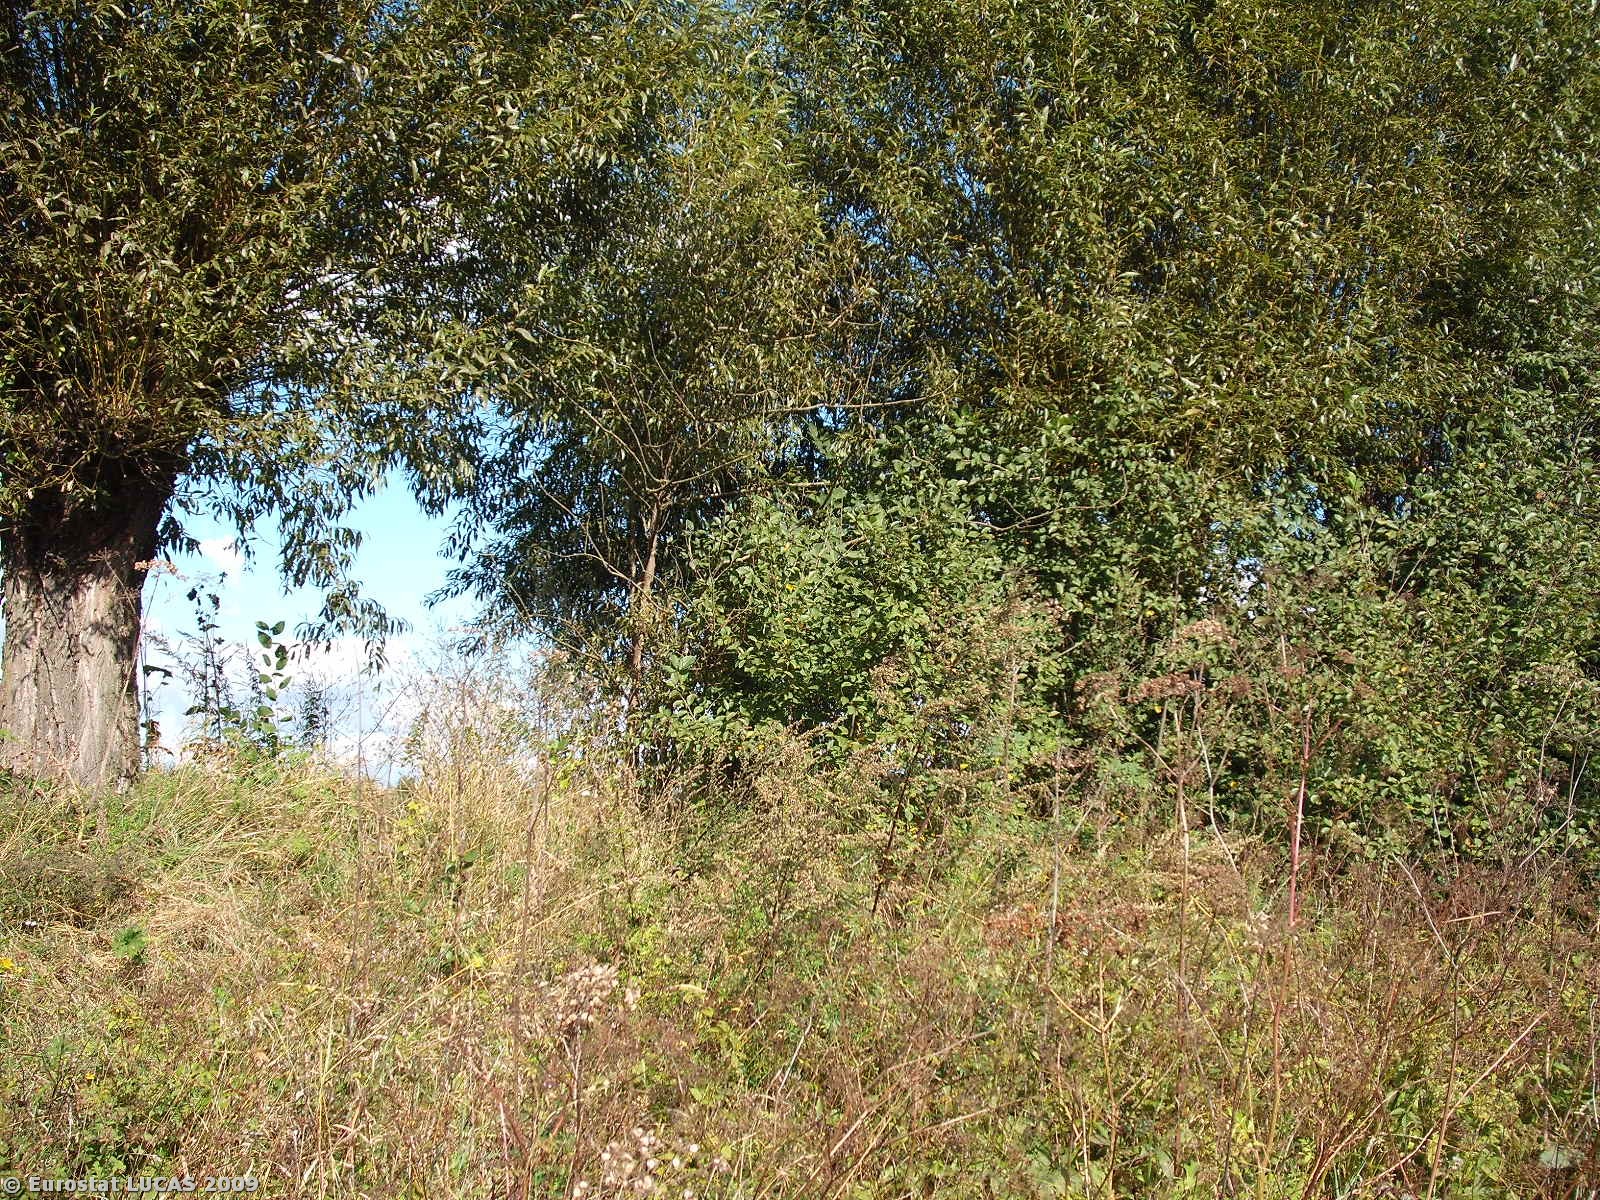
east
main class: Grassland
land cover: Spontaneously vegetated surfaces
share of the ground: > 75 %
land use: Unused
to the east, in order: Spontaneously vegetated surfaces; Lines of trees; Ditches and canals; Grass margins; Tracks; Grassland without tree/shrub cover; Electric lines; Grassland without tree/shrub cover; Broadleaved woodland; Fences; Artificial constructions in urban areas; Fences; Maize; Potatoes
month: September
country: PL
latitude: 49.9596
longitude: 22.0600
